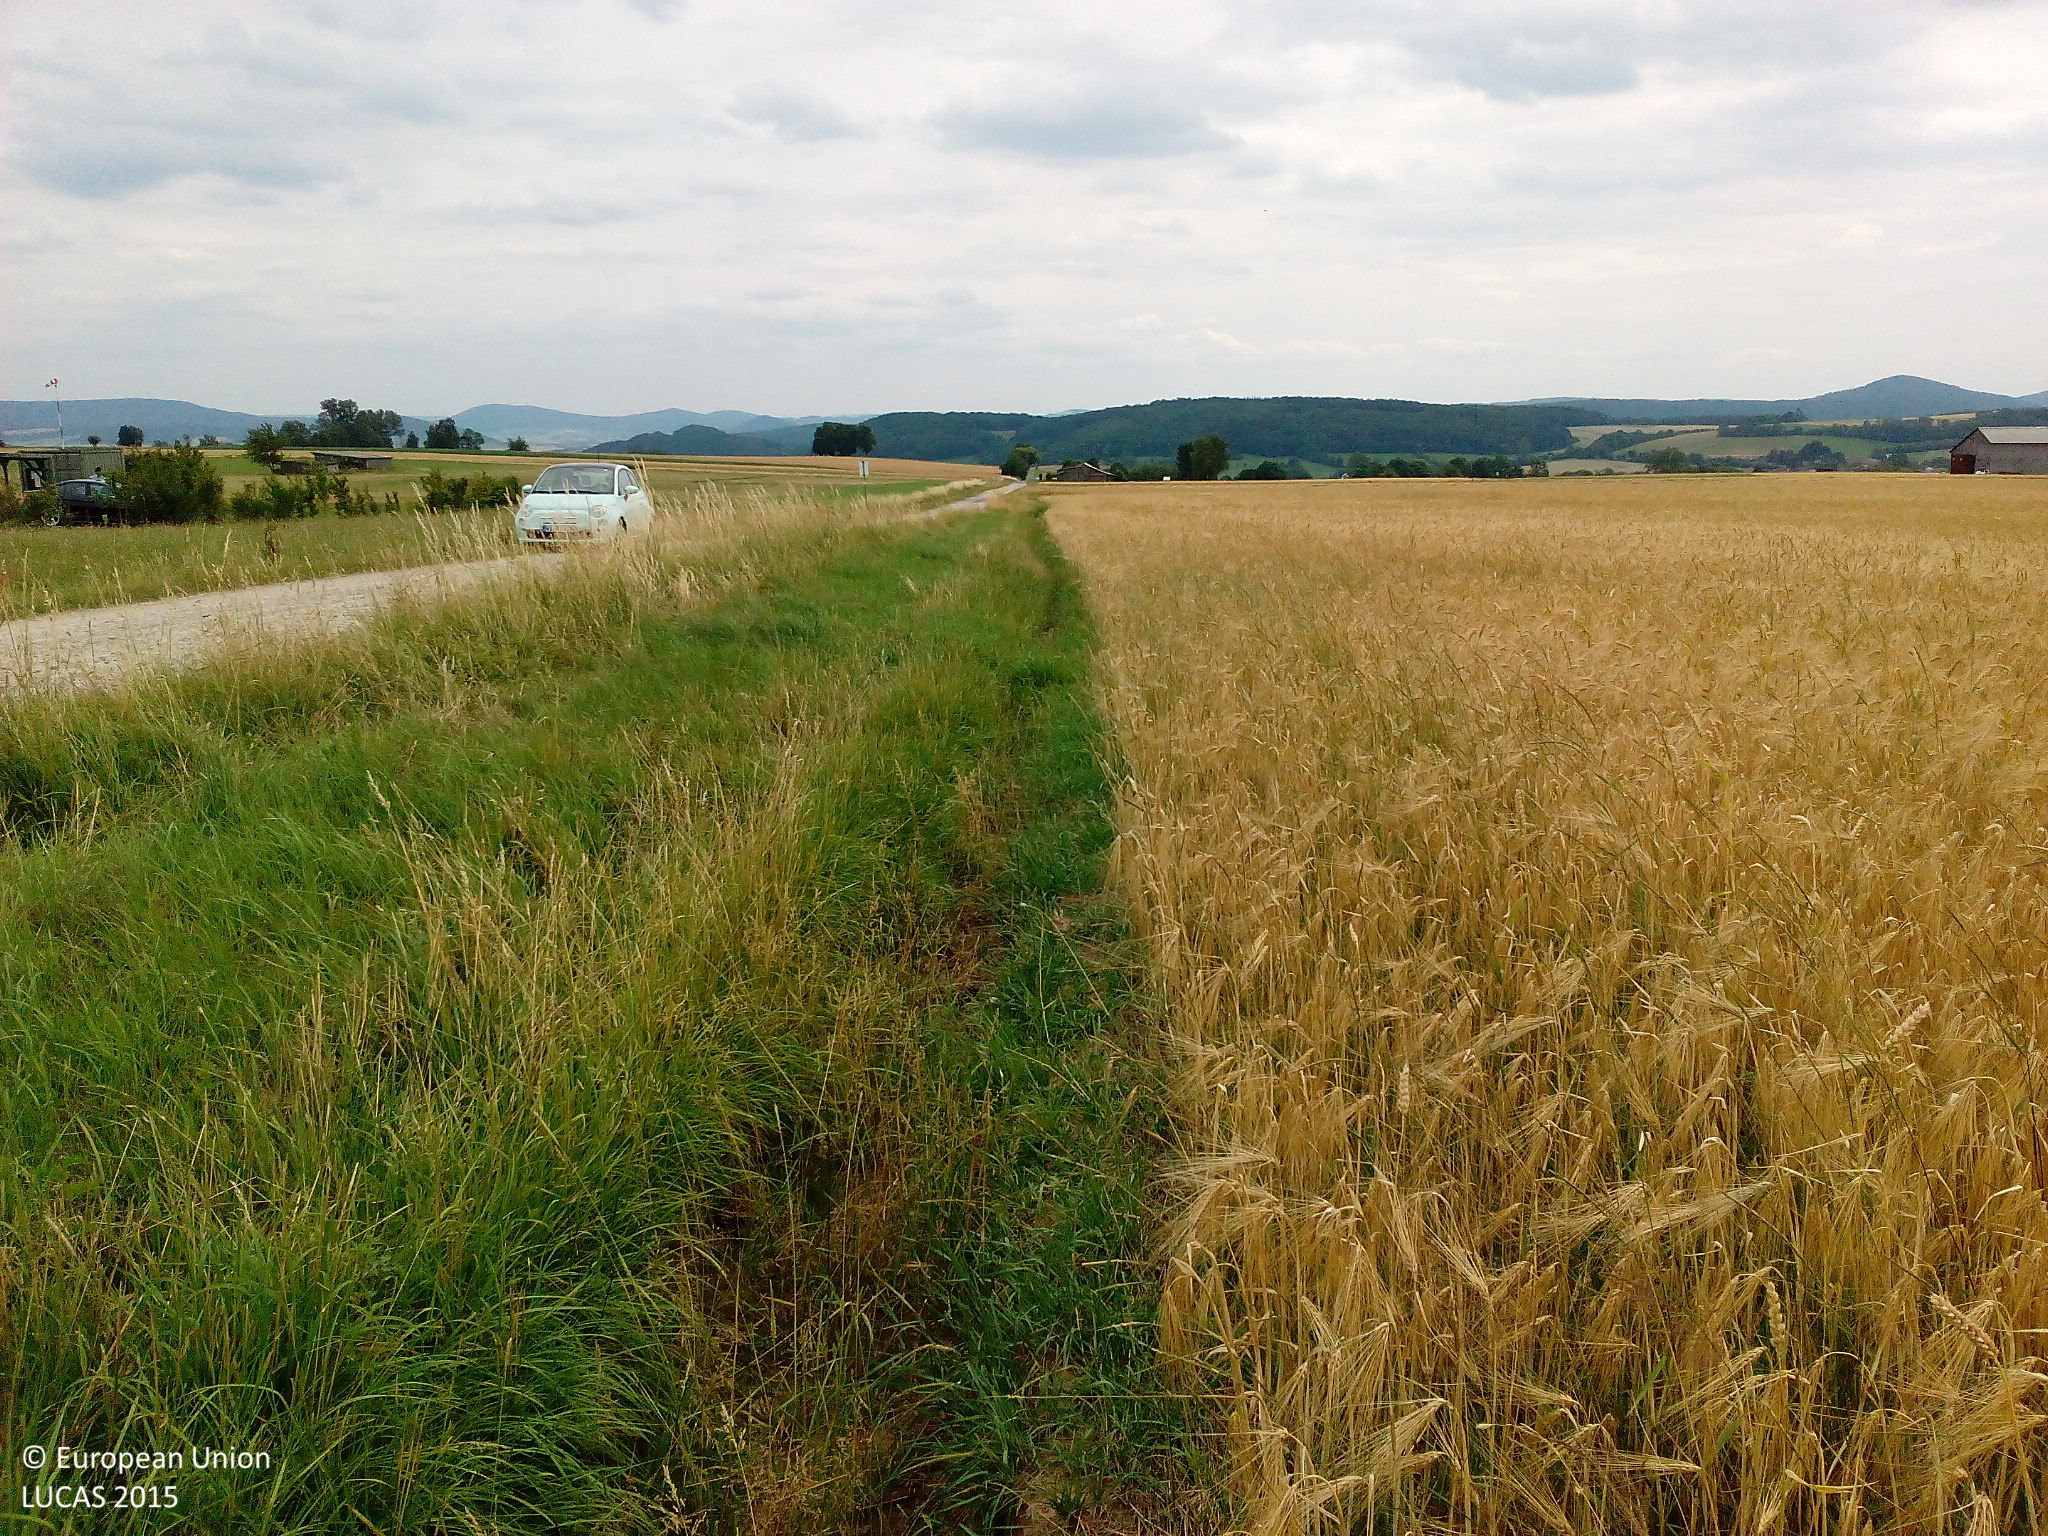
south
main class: Cropland
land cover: Barley
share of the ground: > 75 %
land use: Agriculture (excluding fallow land and kitchen gardens)
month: July
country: DE
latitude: 50.7955
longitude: 9.9291
